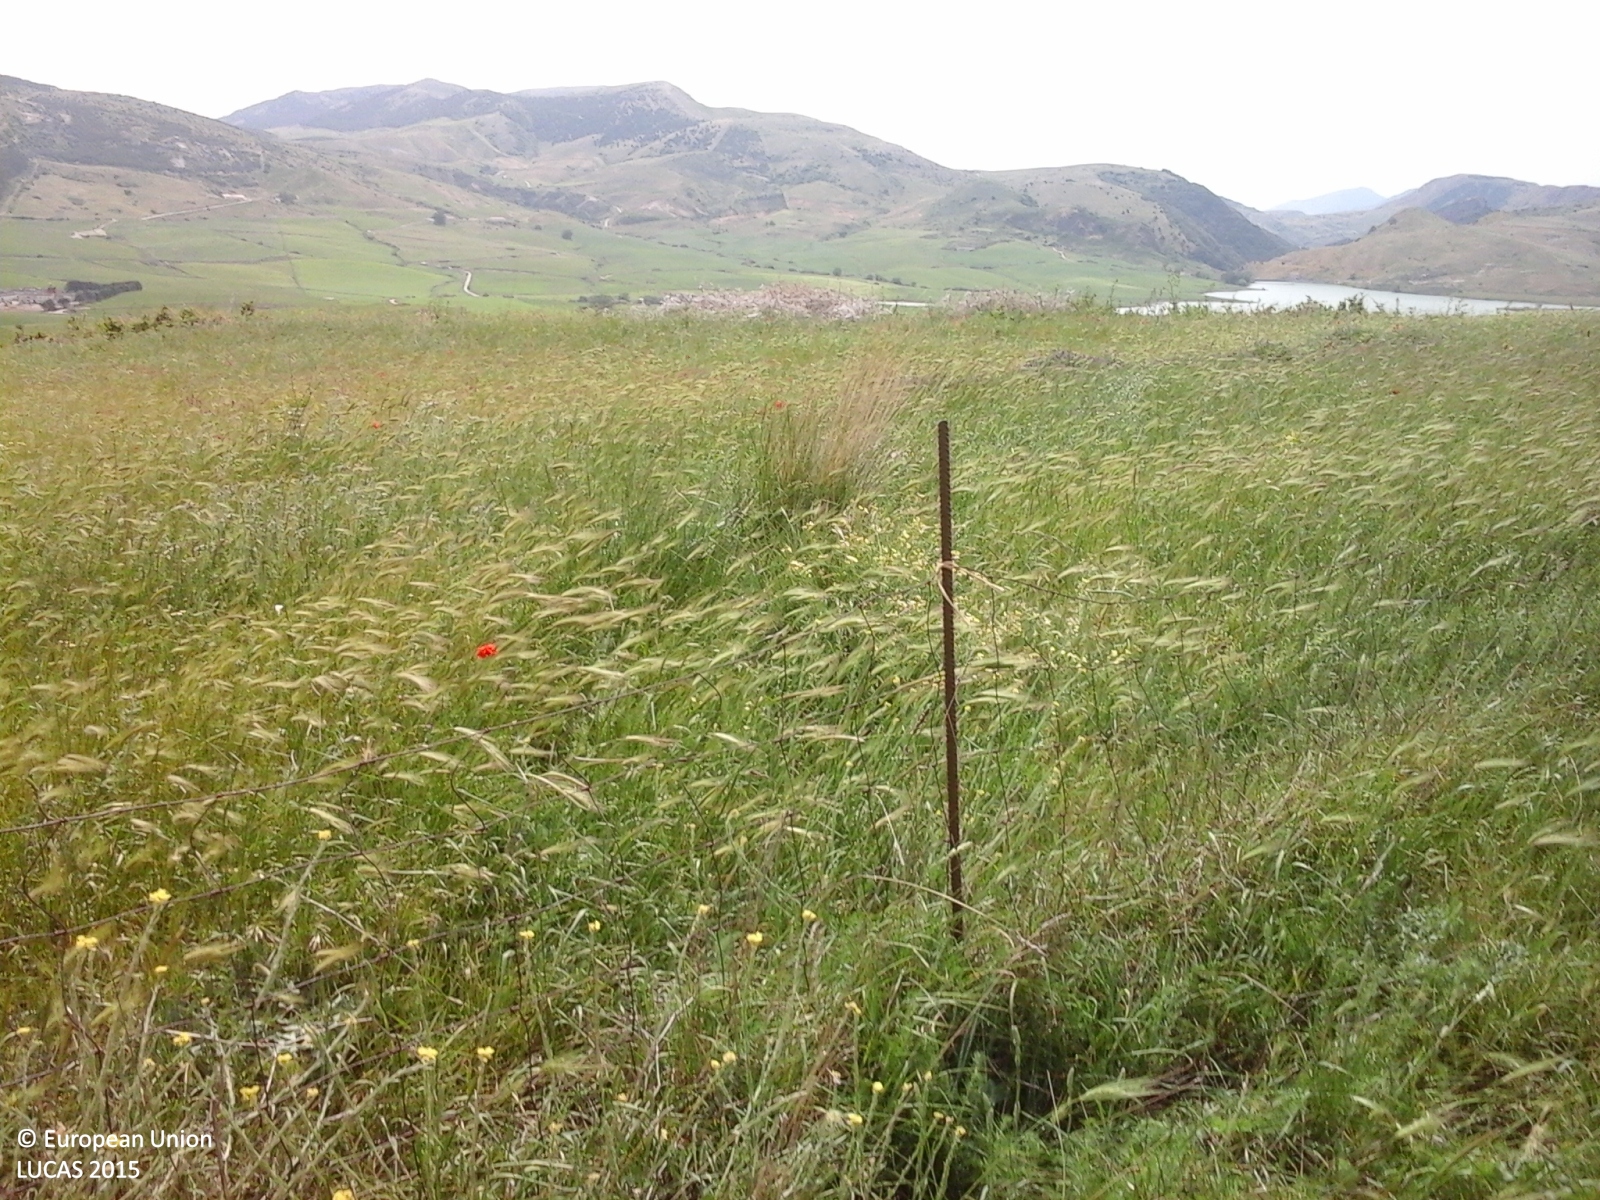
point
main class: Grassland
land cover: Spontaneously vegetated surfaces
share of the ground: > 75 %
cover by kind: herbaceous plants 100 %
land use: Agriculture (excluding fallow land and kitchen gardens)
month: May
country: IT
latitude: 37.6650
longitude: 13.4997
